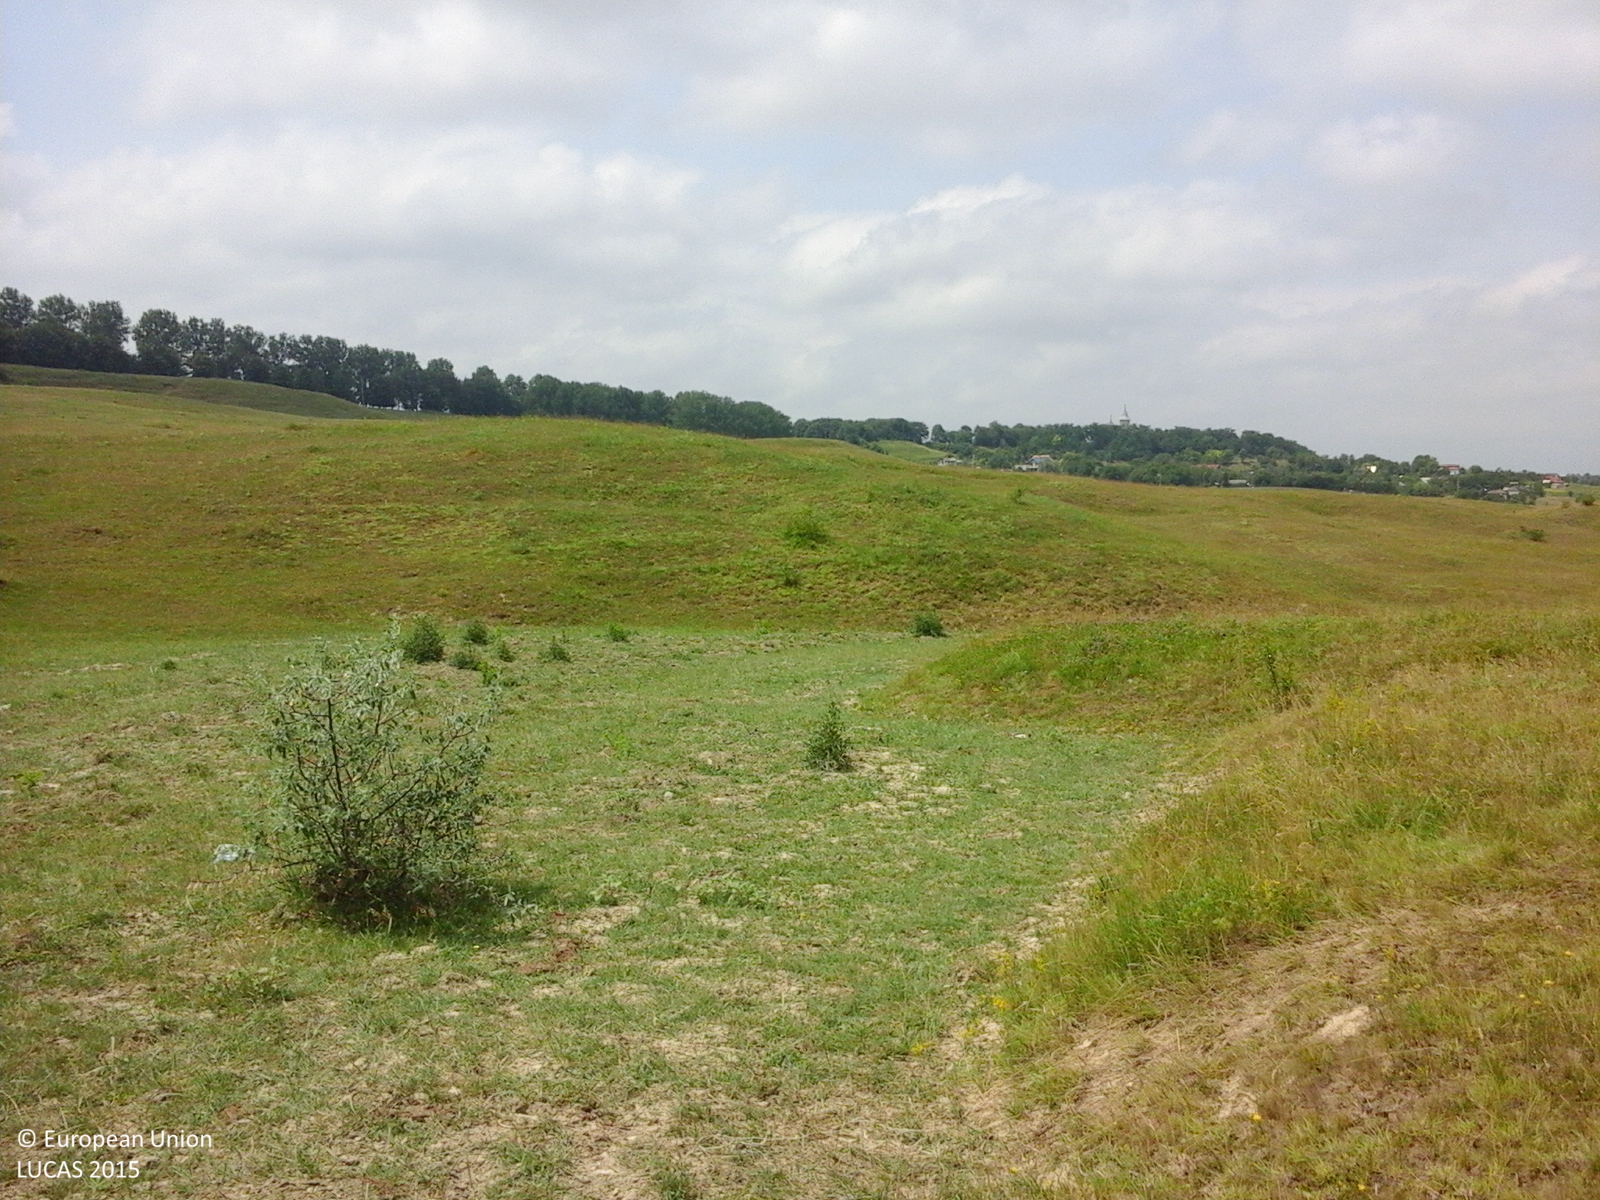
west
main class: Grassland
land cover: Grassland with sparse tree/shrub cover
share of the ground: > 75 %
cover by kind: herbaceous plants 85 %, shrubs 10 %, broadleaved forest trees 5 %
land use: Agriculture (excluding fallow land and kitchen gardens)
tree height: < 5 m
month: June
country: RO
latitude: 47.7645
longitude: 26.4603
